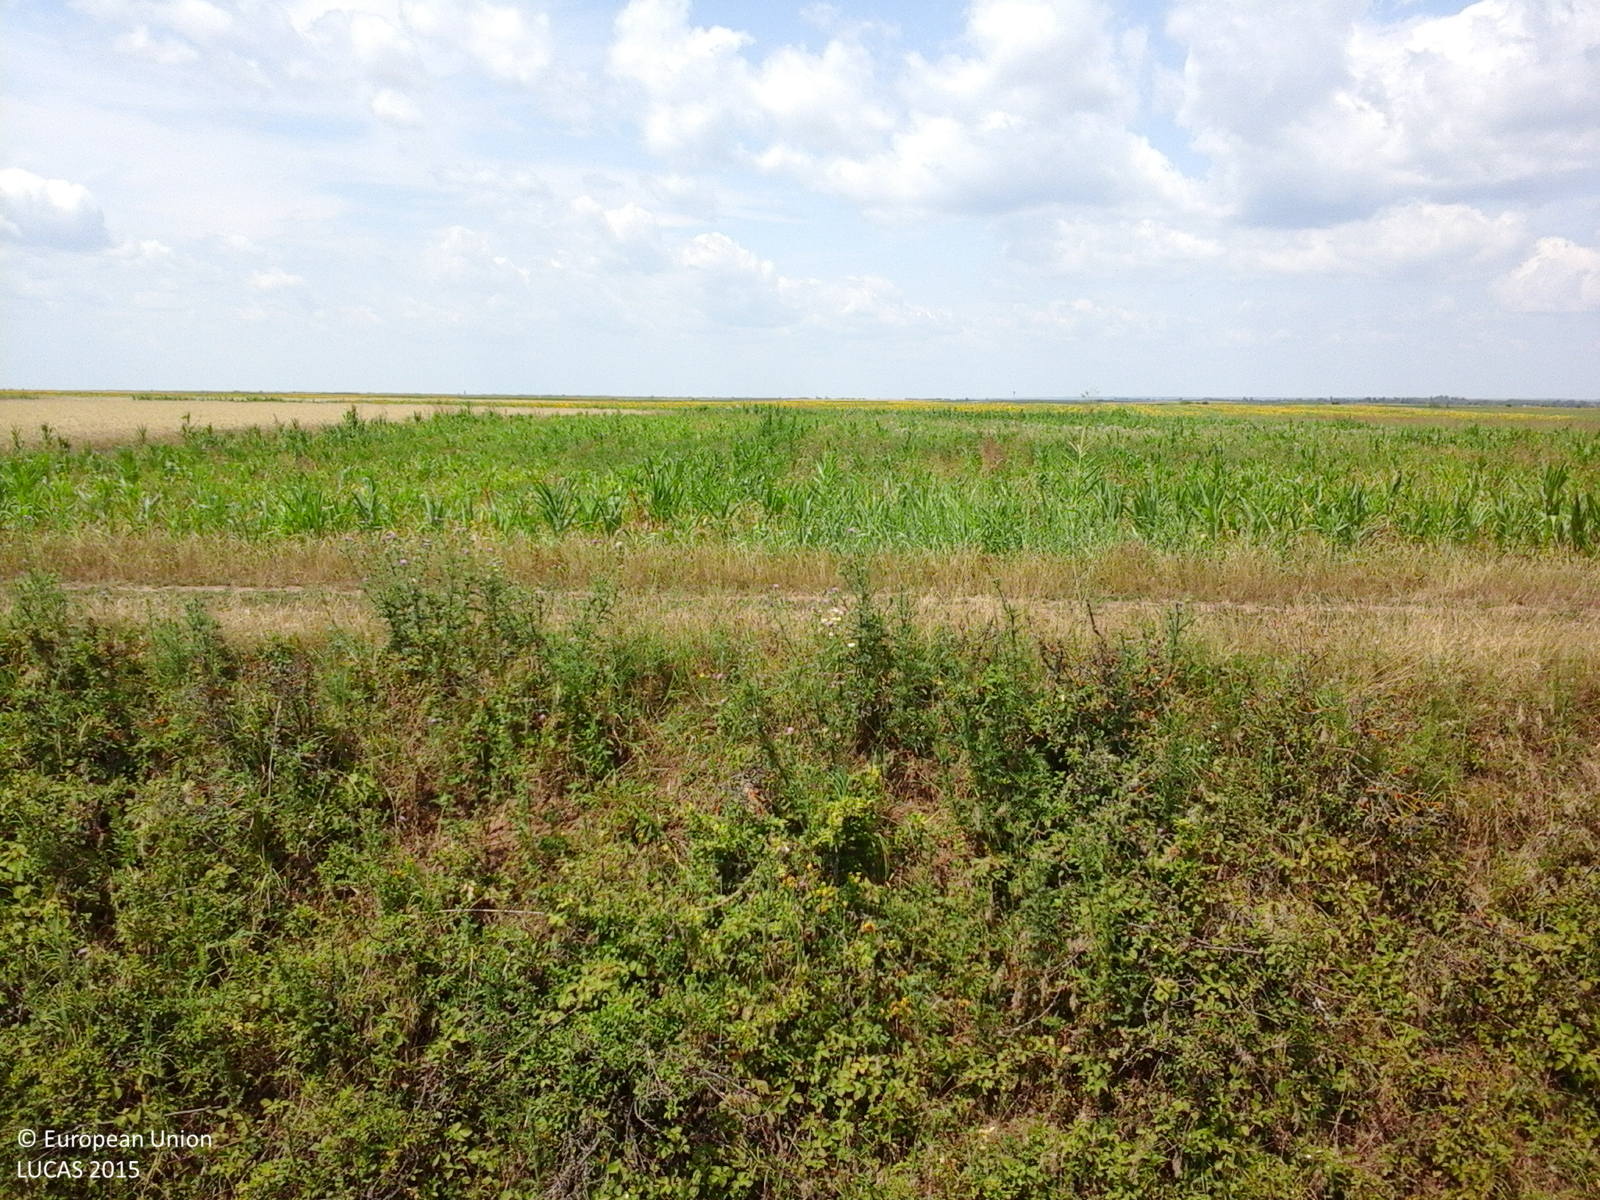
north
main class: Cropland
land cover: Common wheat
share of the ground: > 75 %
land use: Agriculture (excluding fallow land and kitchen gardens)
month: July
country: RO
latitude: 43.9577
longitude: 24.5606
